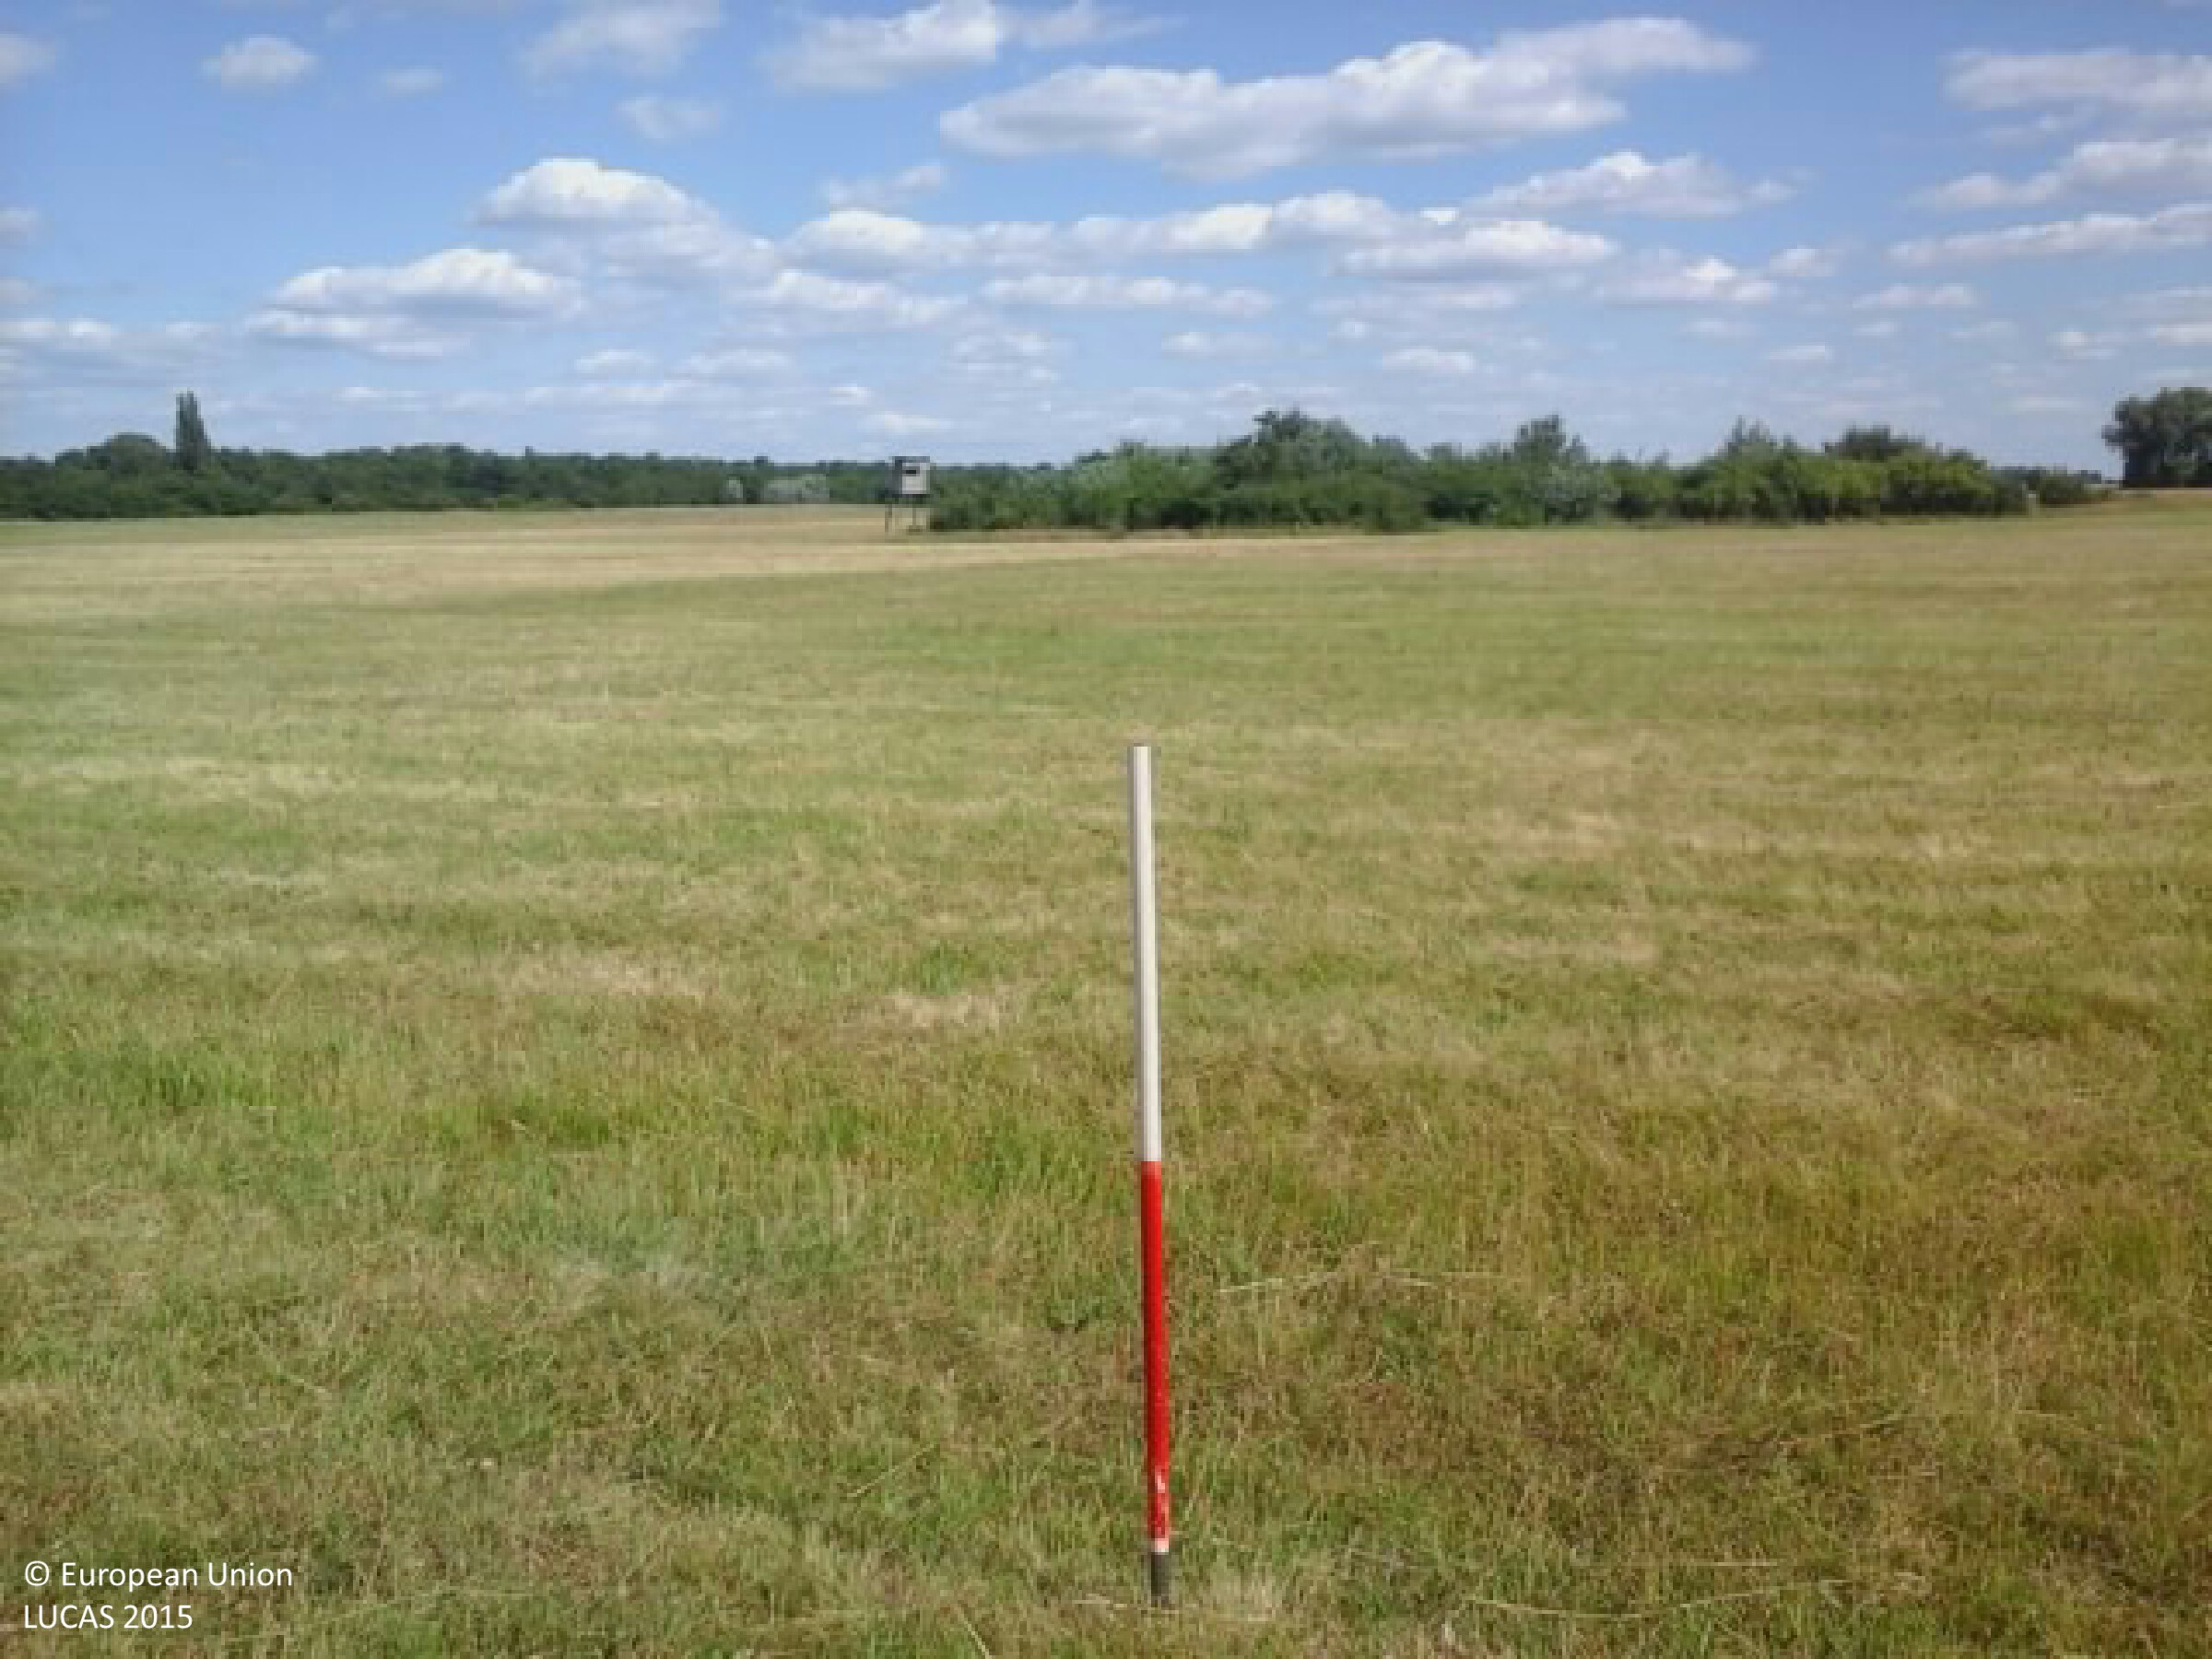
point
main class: Grassland
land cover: Grassland without tree/shrub cover
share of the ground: > 75 %
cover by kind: herbaceous plants 100 %
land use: Agriculture (excluding fallow land and kitchen gardens)
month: June
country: HU
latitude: 46.2811
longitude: 19.1898
